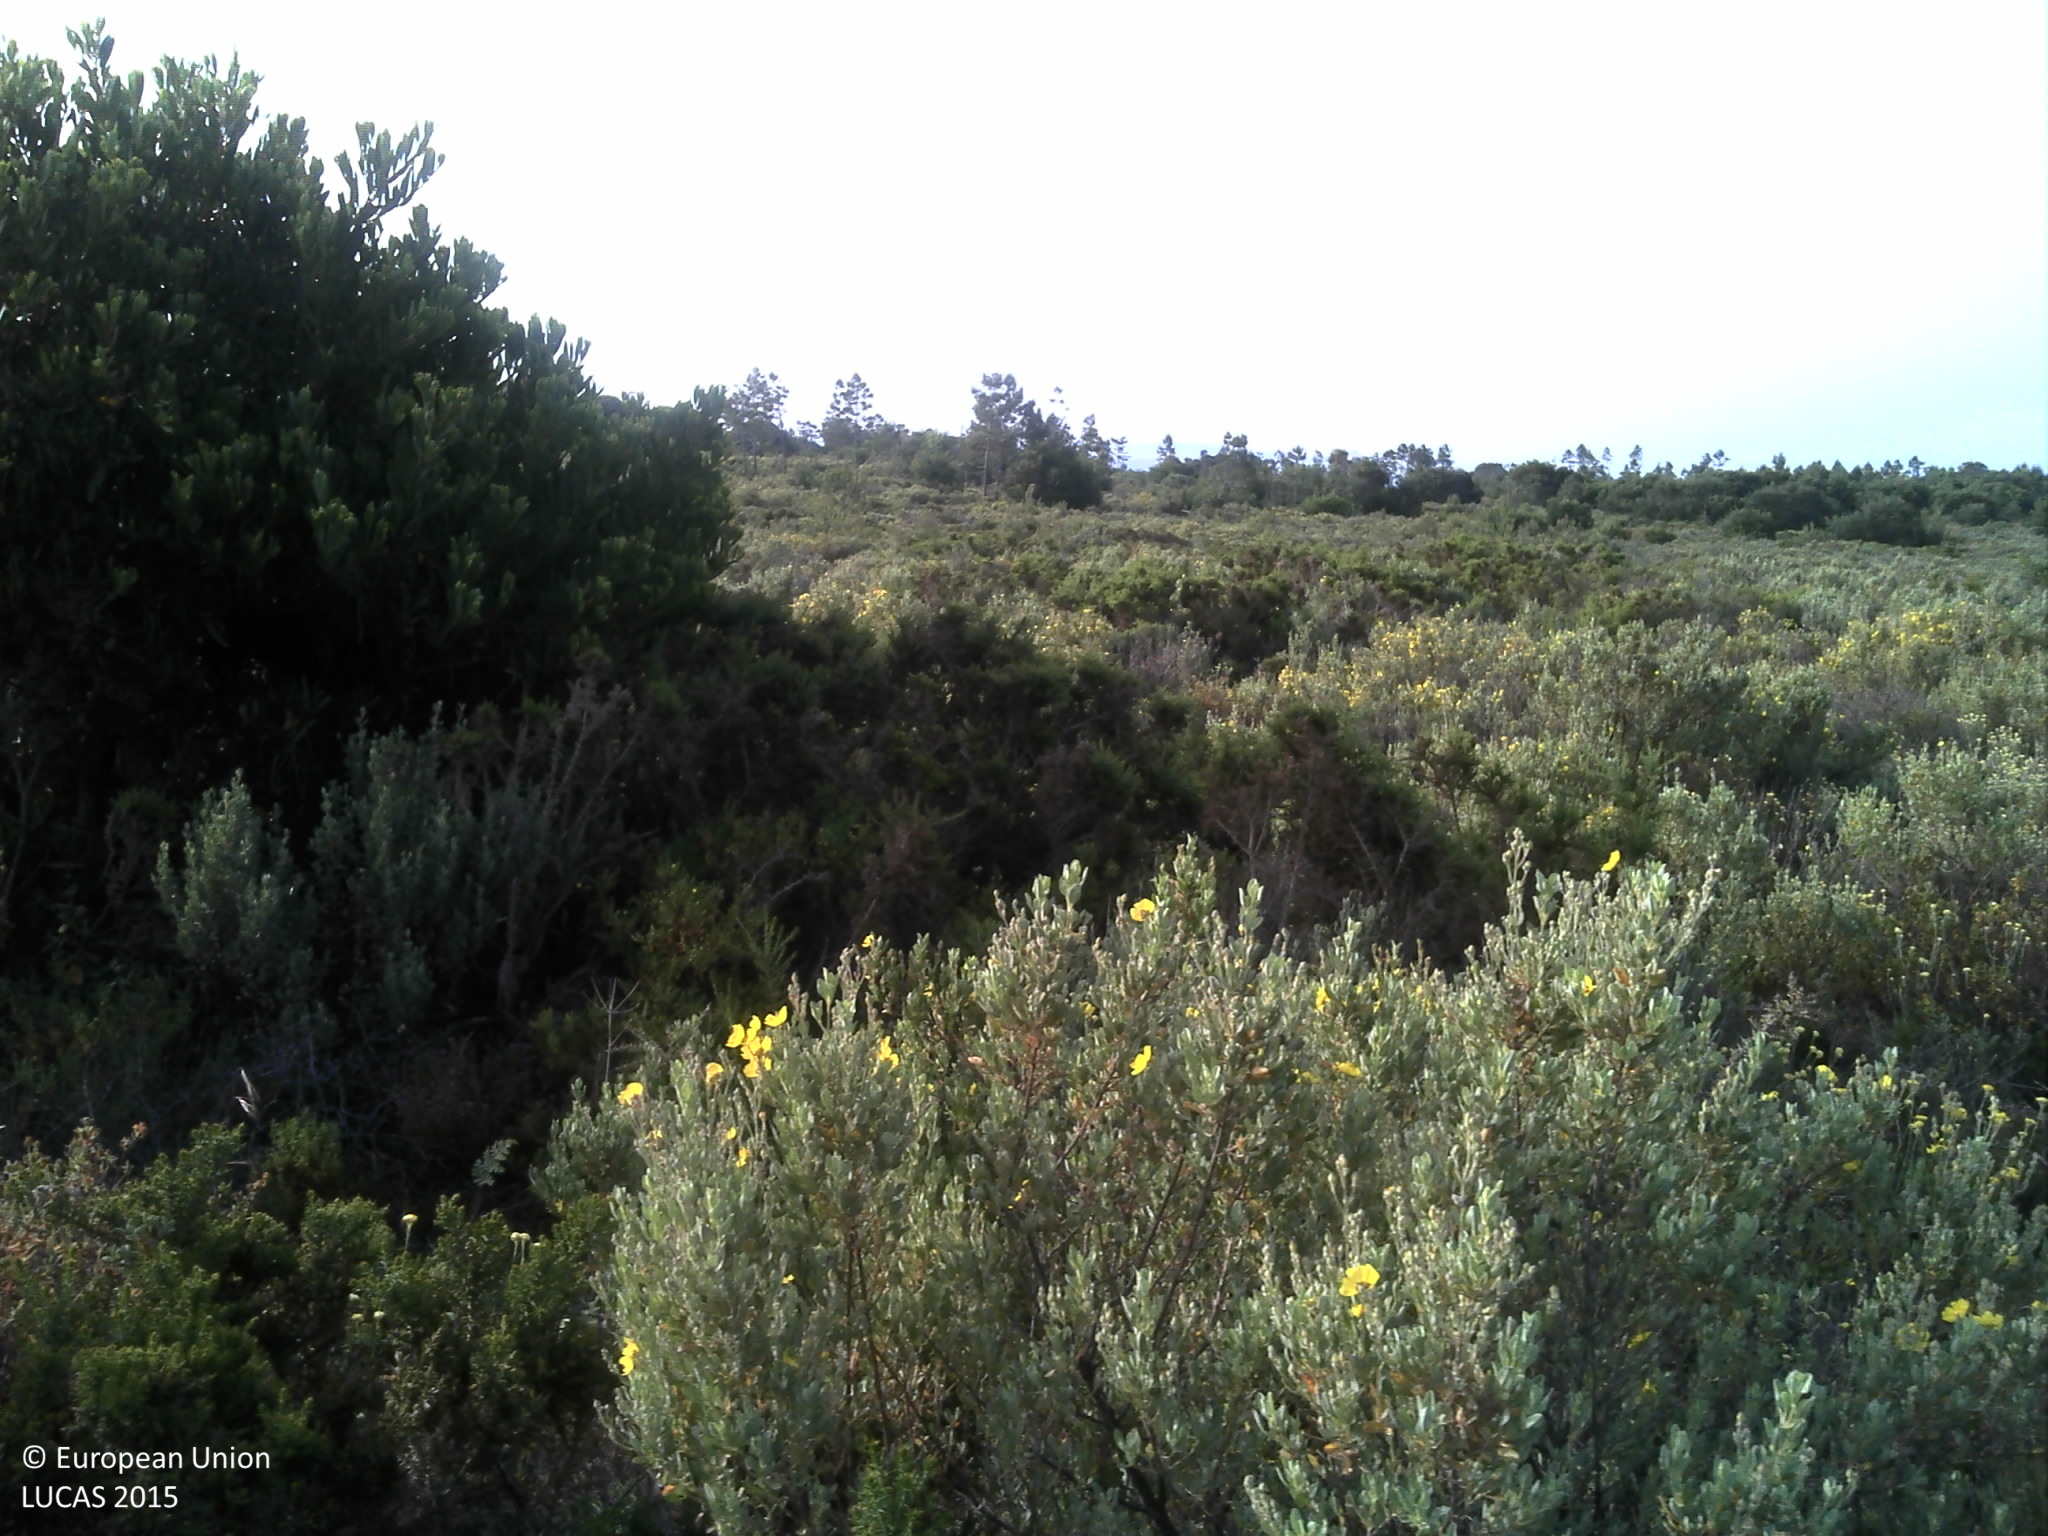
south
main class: Shrubland
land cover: Shrubland with sparse tree cover
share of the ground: 50 - 75 %
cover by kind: shrubs 60 %, herbaceous plants 25 %, consolidated bare surface 10 %, coniferous forest trees 5 %
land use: Semi-natural and natural areas not in use
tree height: < 5 m
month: May
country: PT
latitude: 37.6351
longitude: -8.7974
